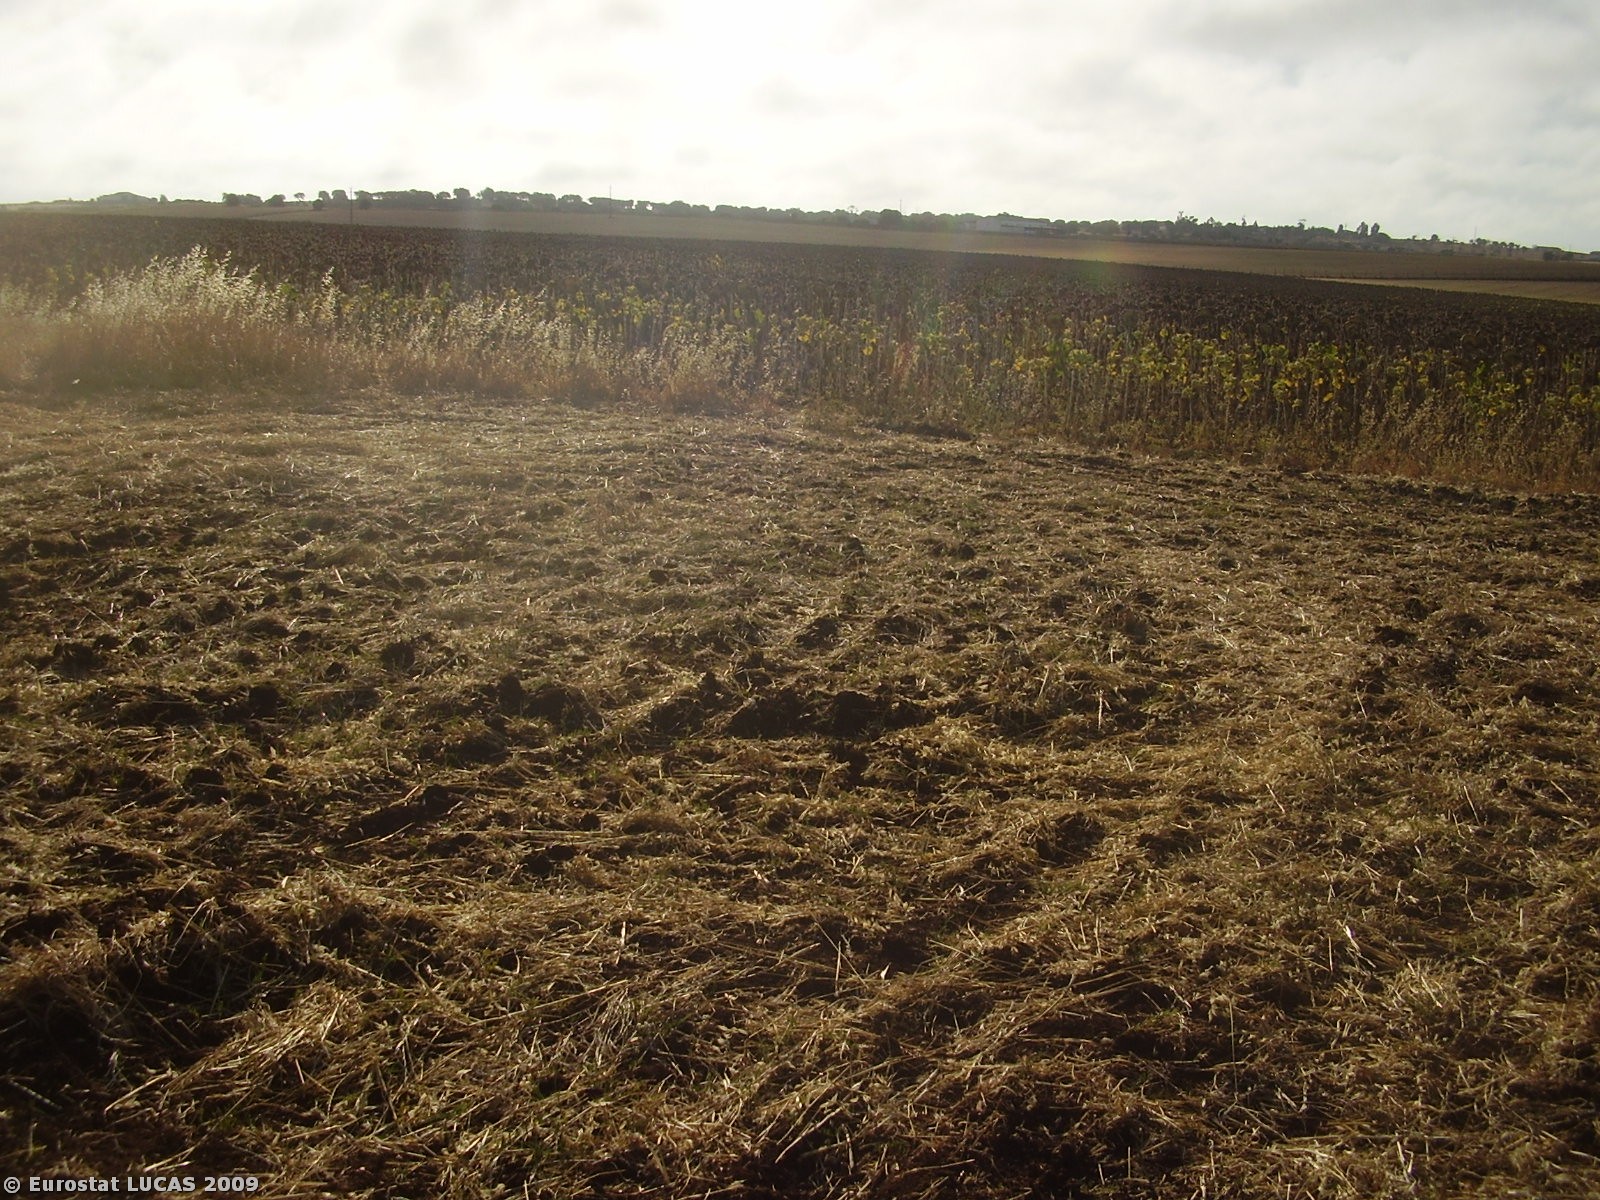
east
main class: Cropland
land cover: Olive groves
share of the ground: 10 - 25 %
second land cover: Oats
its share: > 75 %
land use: Agriculture (excluding fallow land and kitchen gardens)
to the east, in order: Olive groves; Oats; Olive groves; Oats; Sunflower
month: August
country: PT
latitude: 38.0762
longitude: -7.9631
